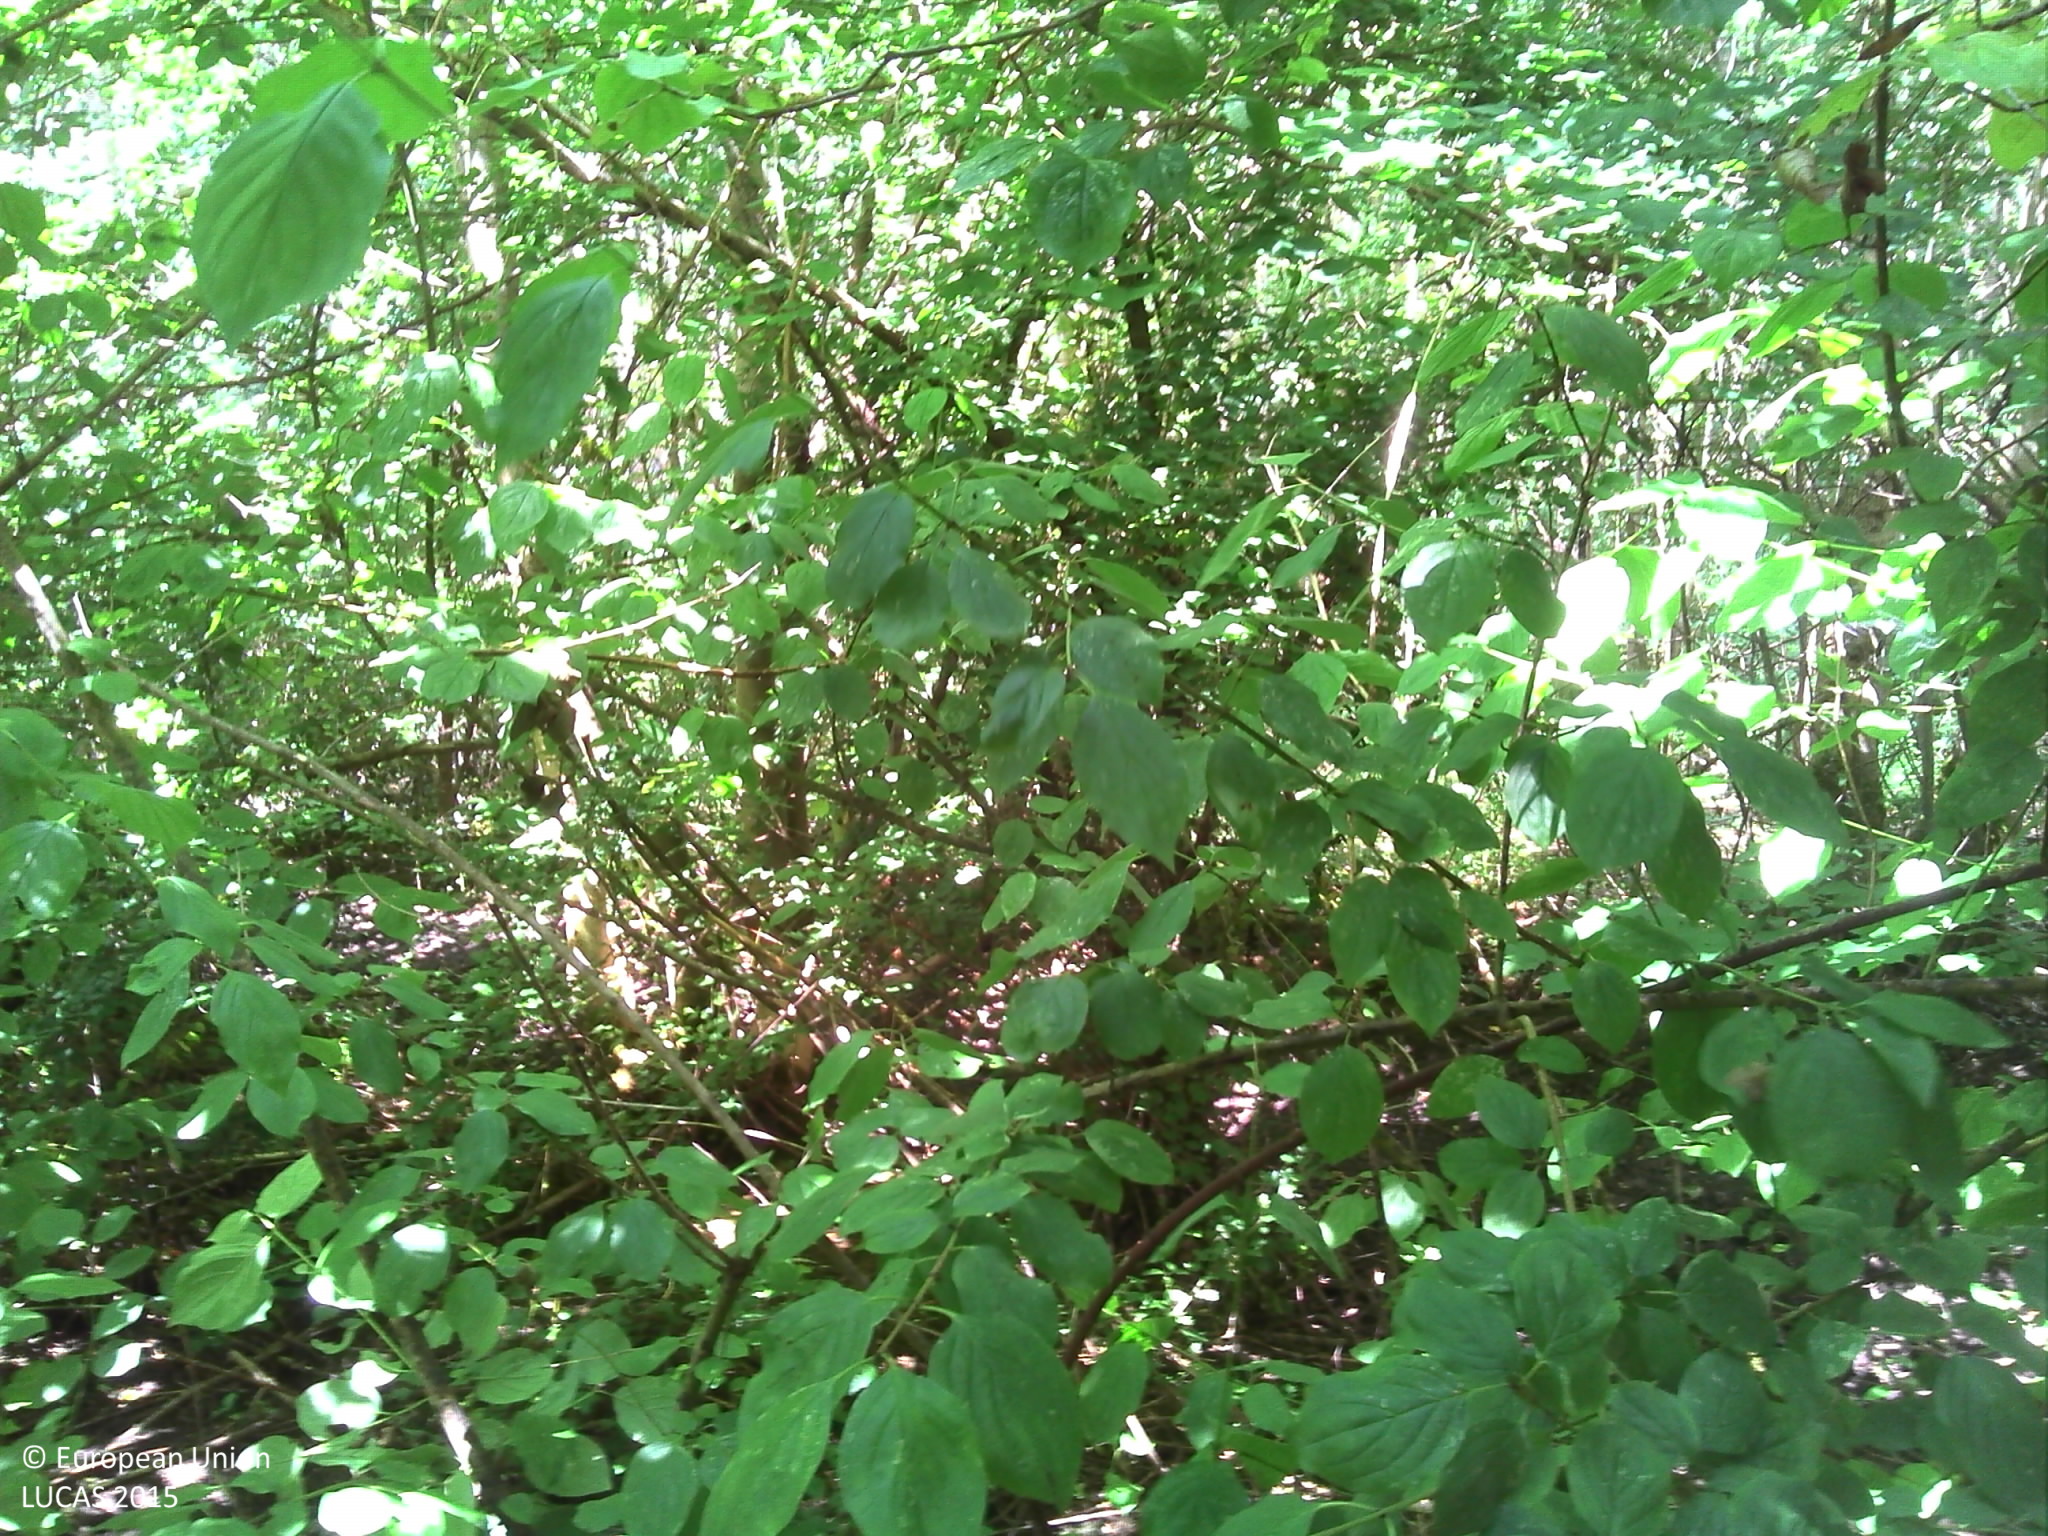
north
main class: Woodland
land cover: Broadleaved woodland
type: acidophilous oak and oak-birch forest
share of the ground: > 75 %
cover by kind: broadleaved forest trees 50 %, herbaceous plants 25 %, lichens and mosses 10 %, unconsolidated bare surface 10 %
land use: Forestry
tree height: > 5 m
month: July
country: FR
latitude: 48.5366
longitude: 3.8057
